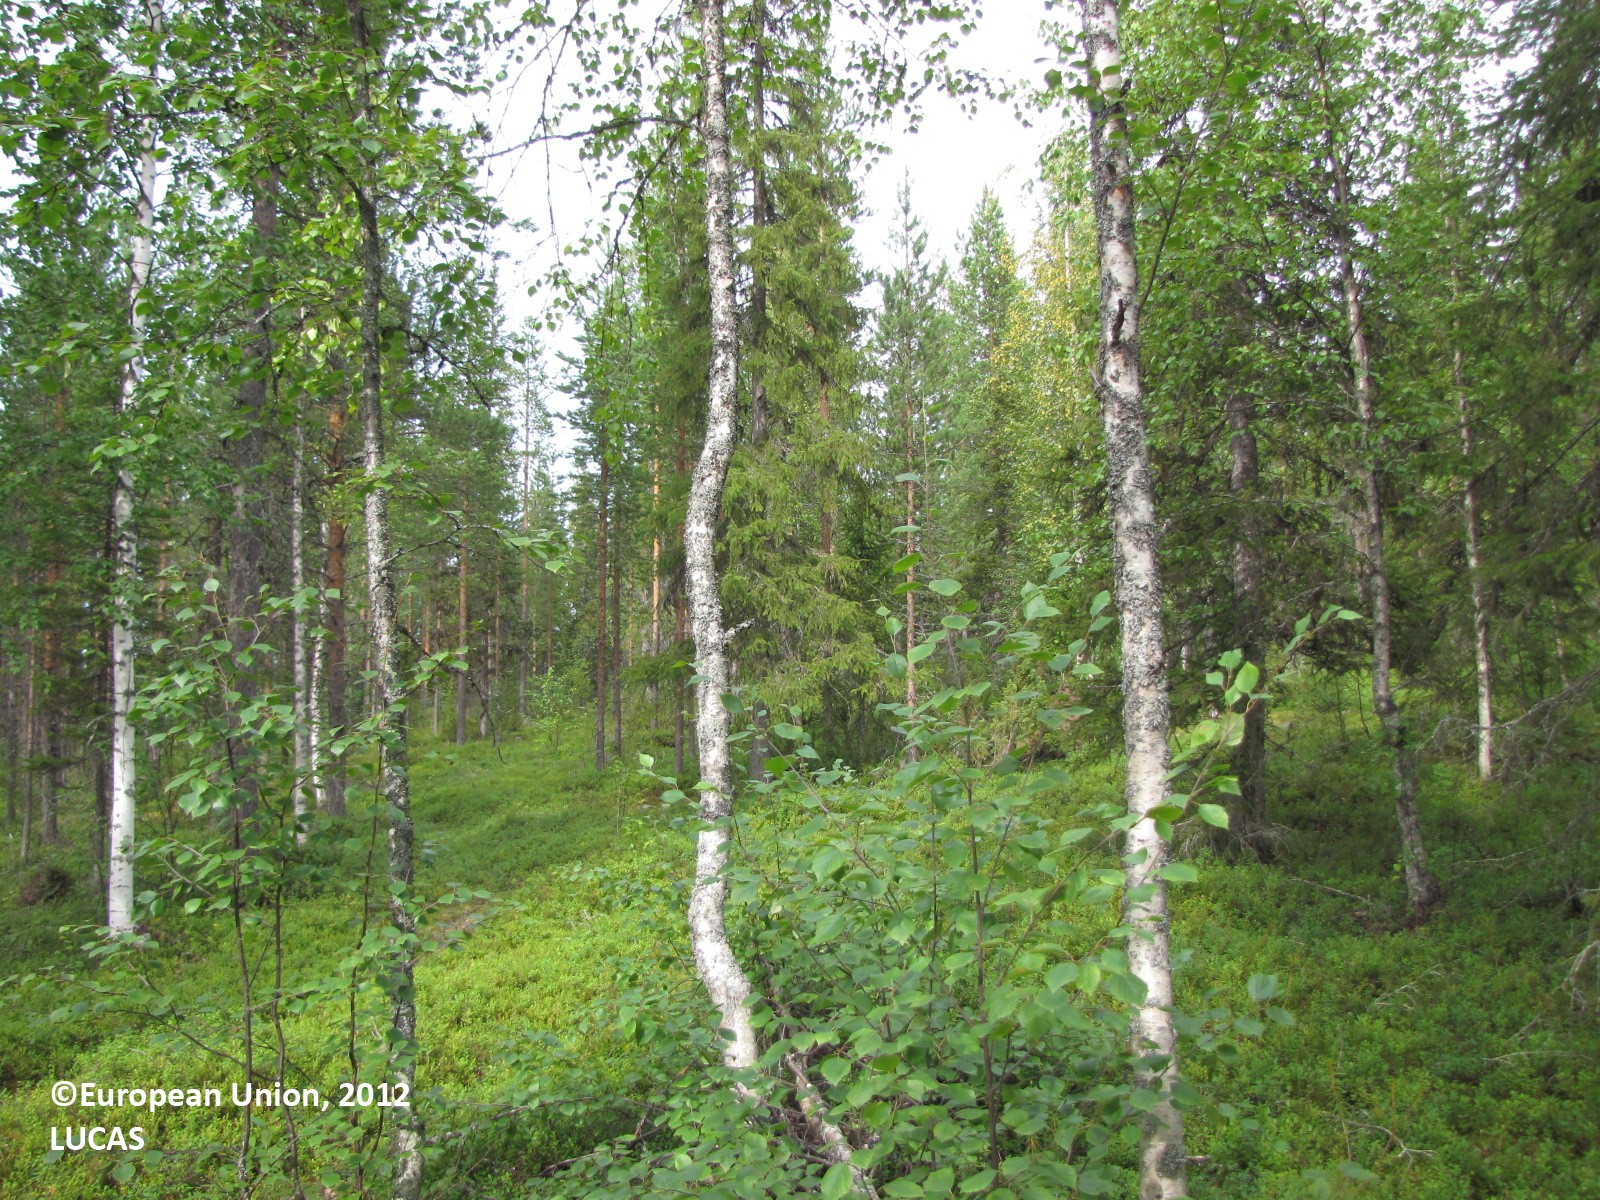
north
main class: Woodland
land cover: Other mixed woodland
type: boreal forest
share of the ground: 10 - 25 %
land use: Forestry
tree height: > 5 m
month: August
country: FI
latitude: 66.8508
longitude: 24.8863
